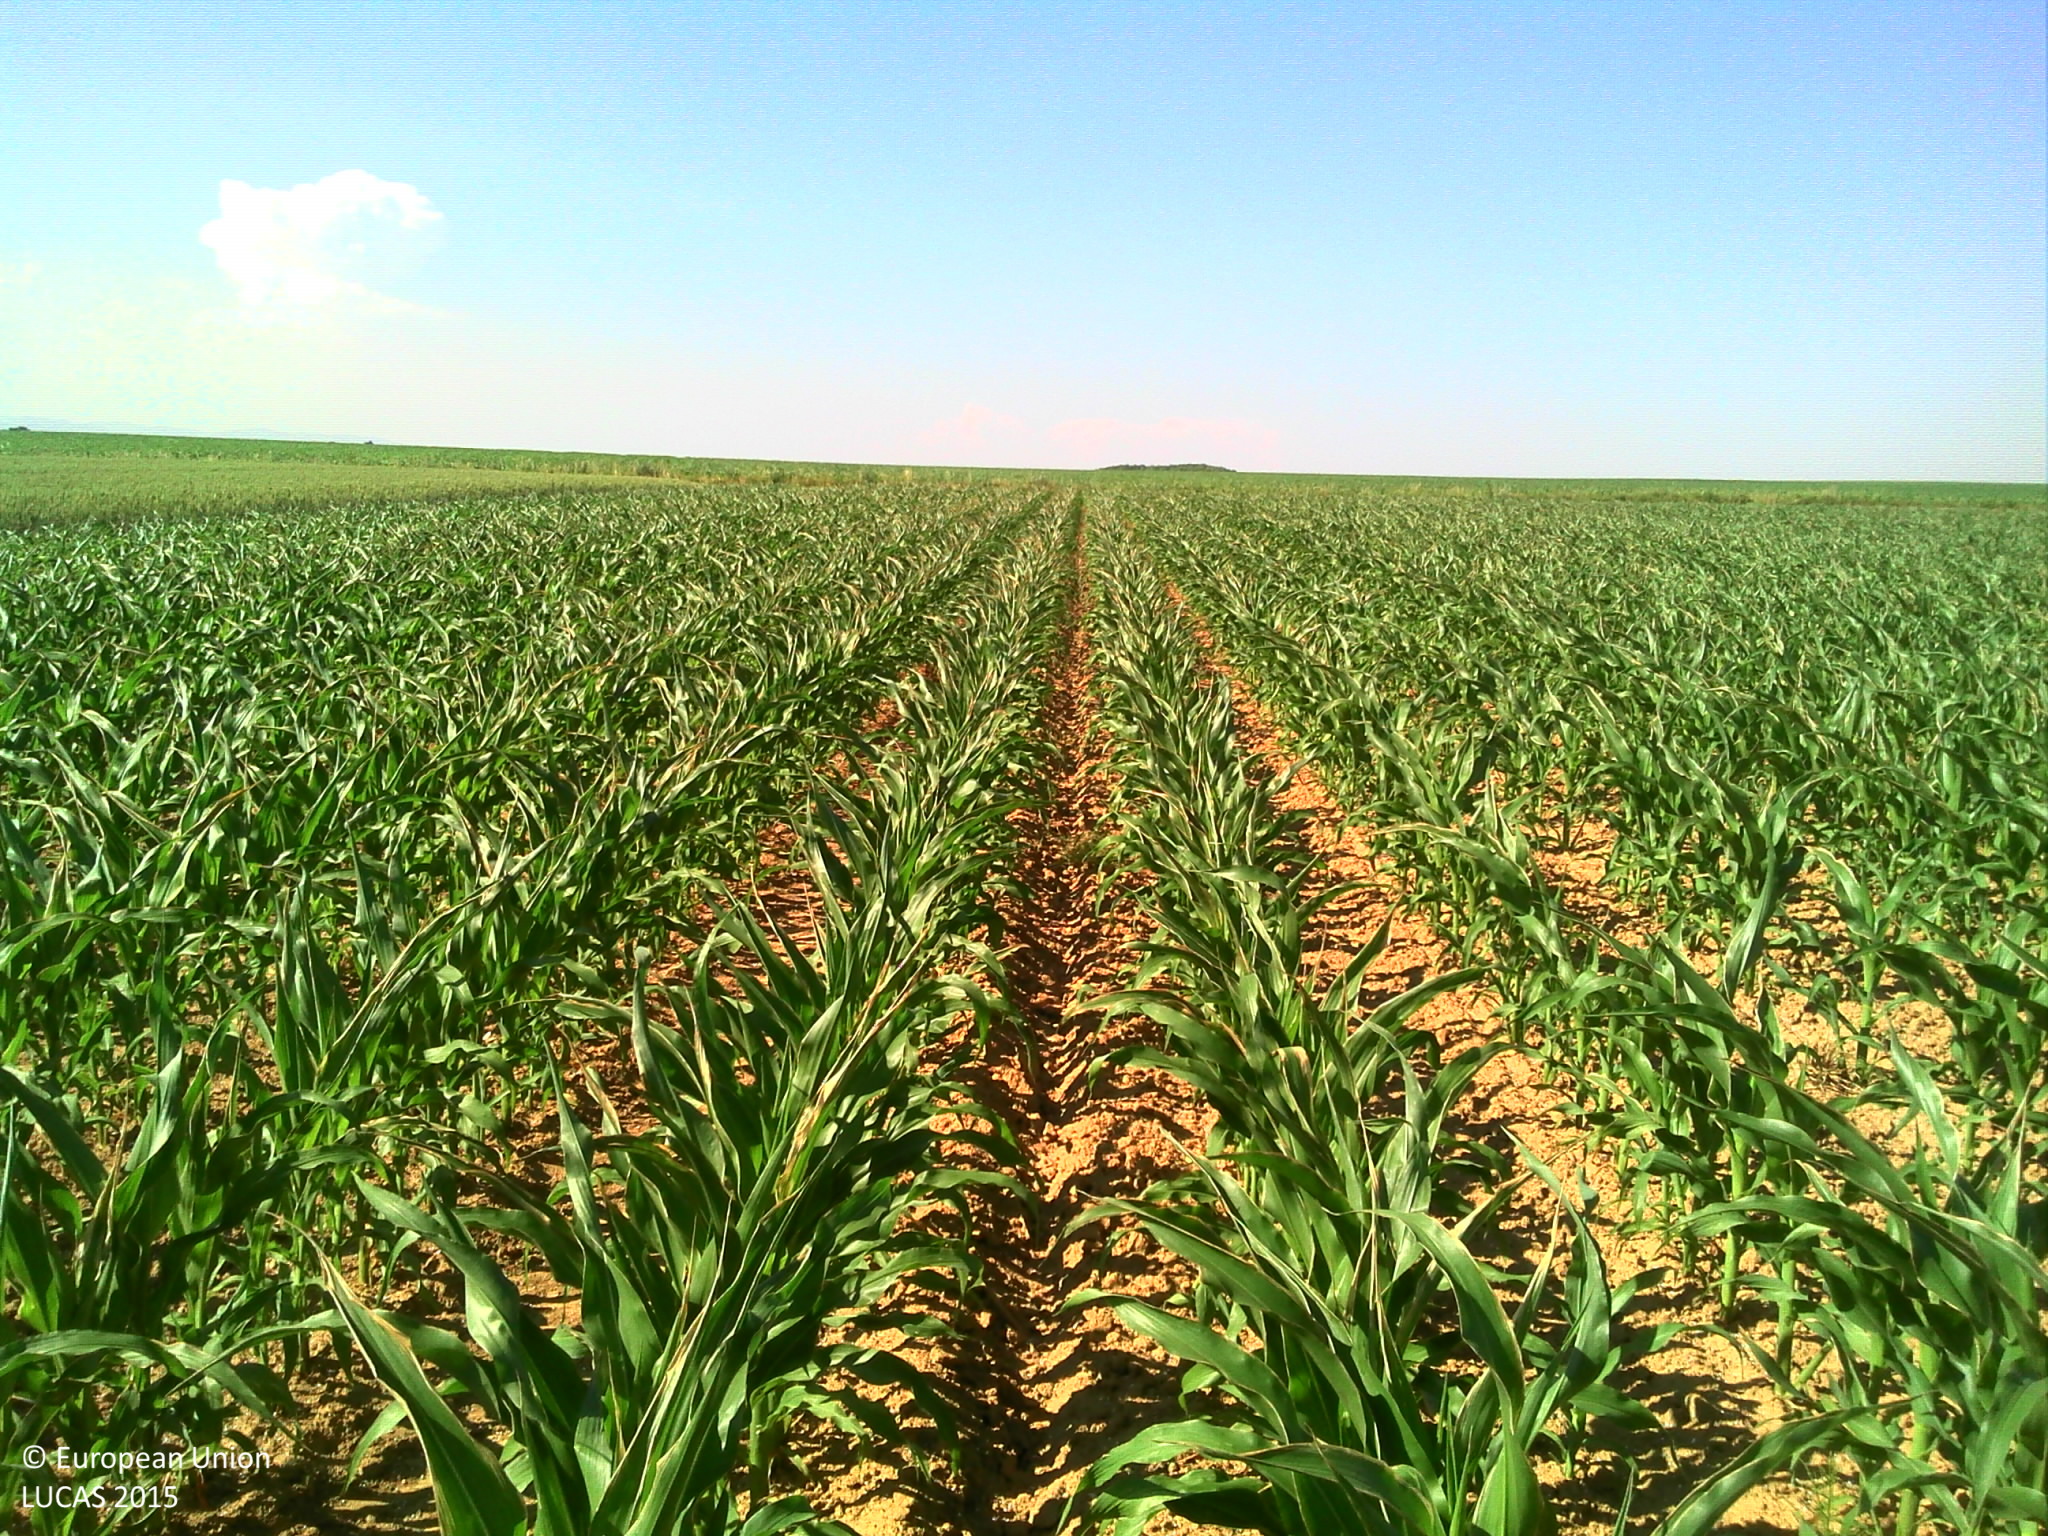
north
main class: Cropland
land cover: Maize
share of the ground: 50 - 75 %
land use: Agriculture (excluding fallow land and kitchen gardens)
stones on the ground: 10 - 25 %
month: June
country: FR
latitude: 45.9734
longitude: 4.8276
